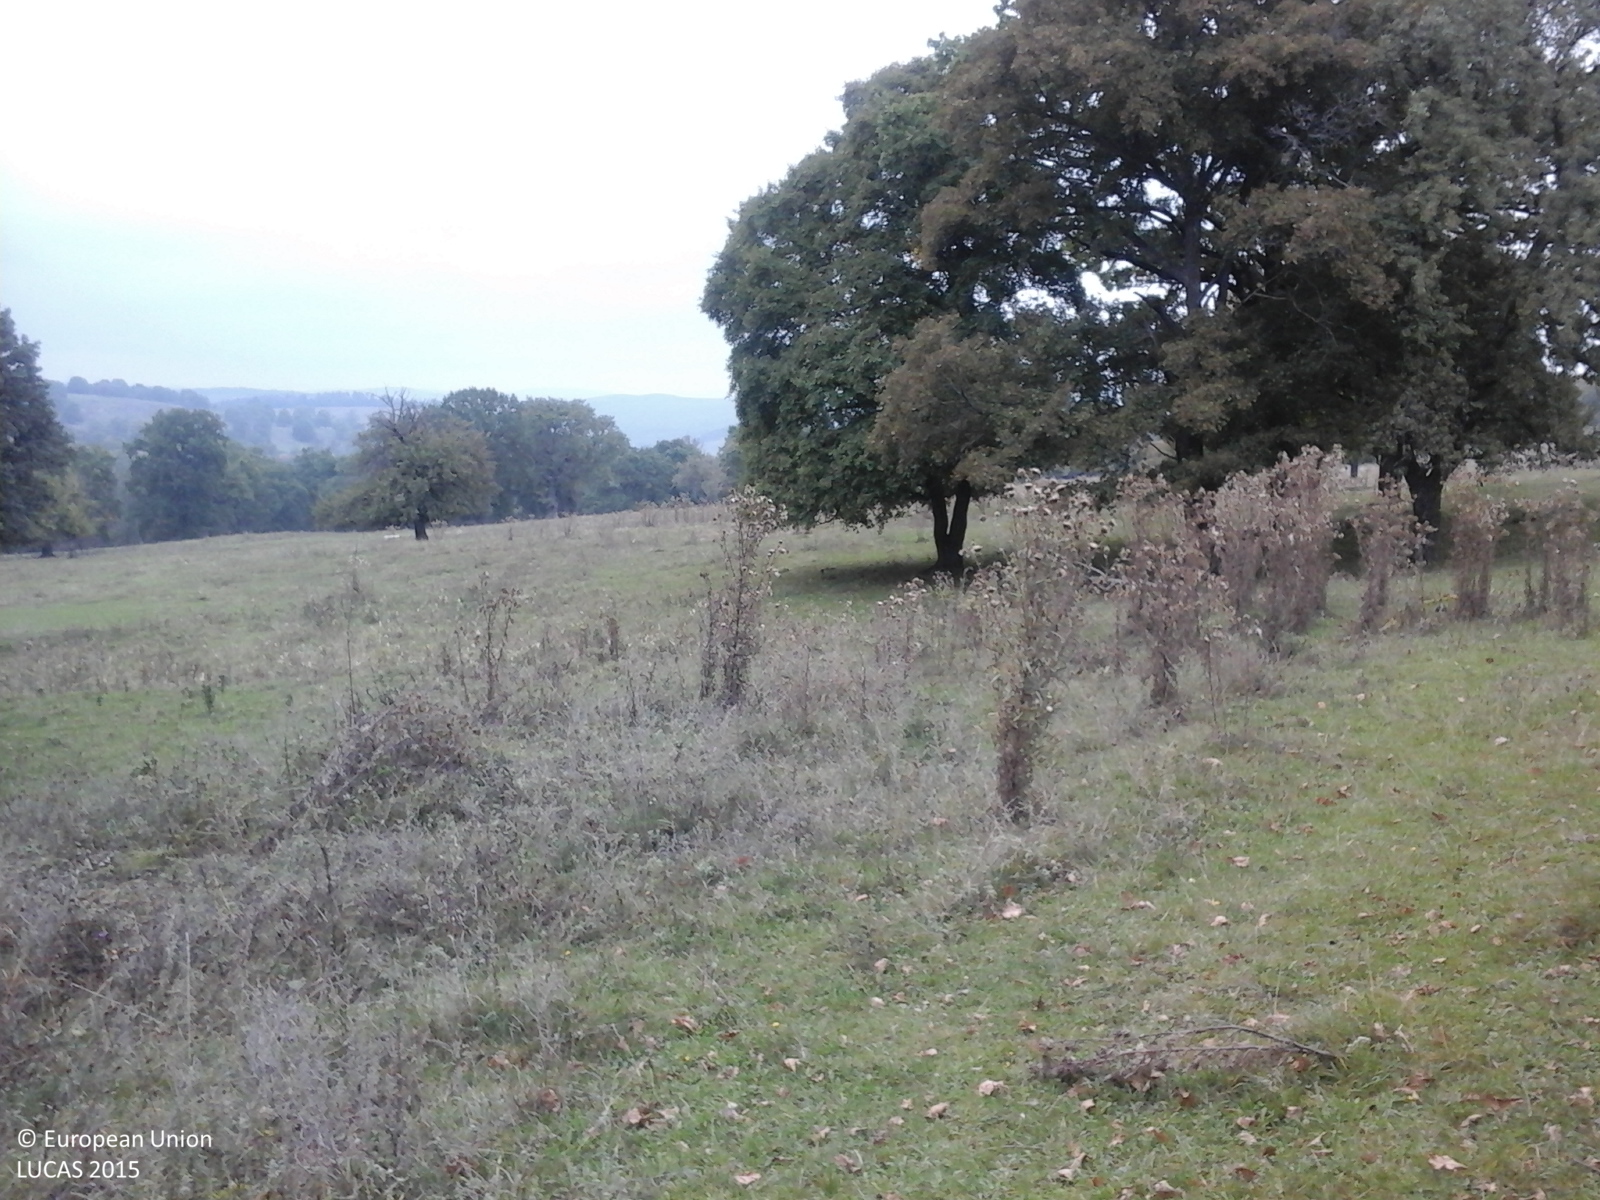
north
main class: Grassland
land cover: Grassland with sparse tree/shrub cover
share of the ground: > 75 %
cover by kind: herbaceous plants 95 %, broadleaved forest trees 5 %
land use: Agriculture (excluding fallow land and kitchen gardens)
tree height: > 5 m
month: October
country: RO
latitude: 46.0049
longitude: 25.2204
